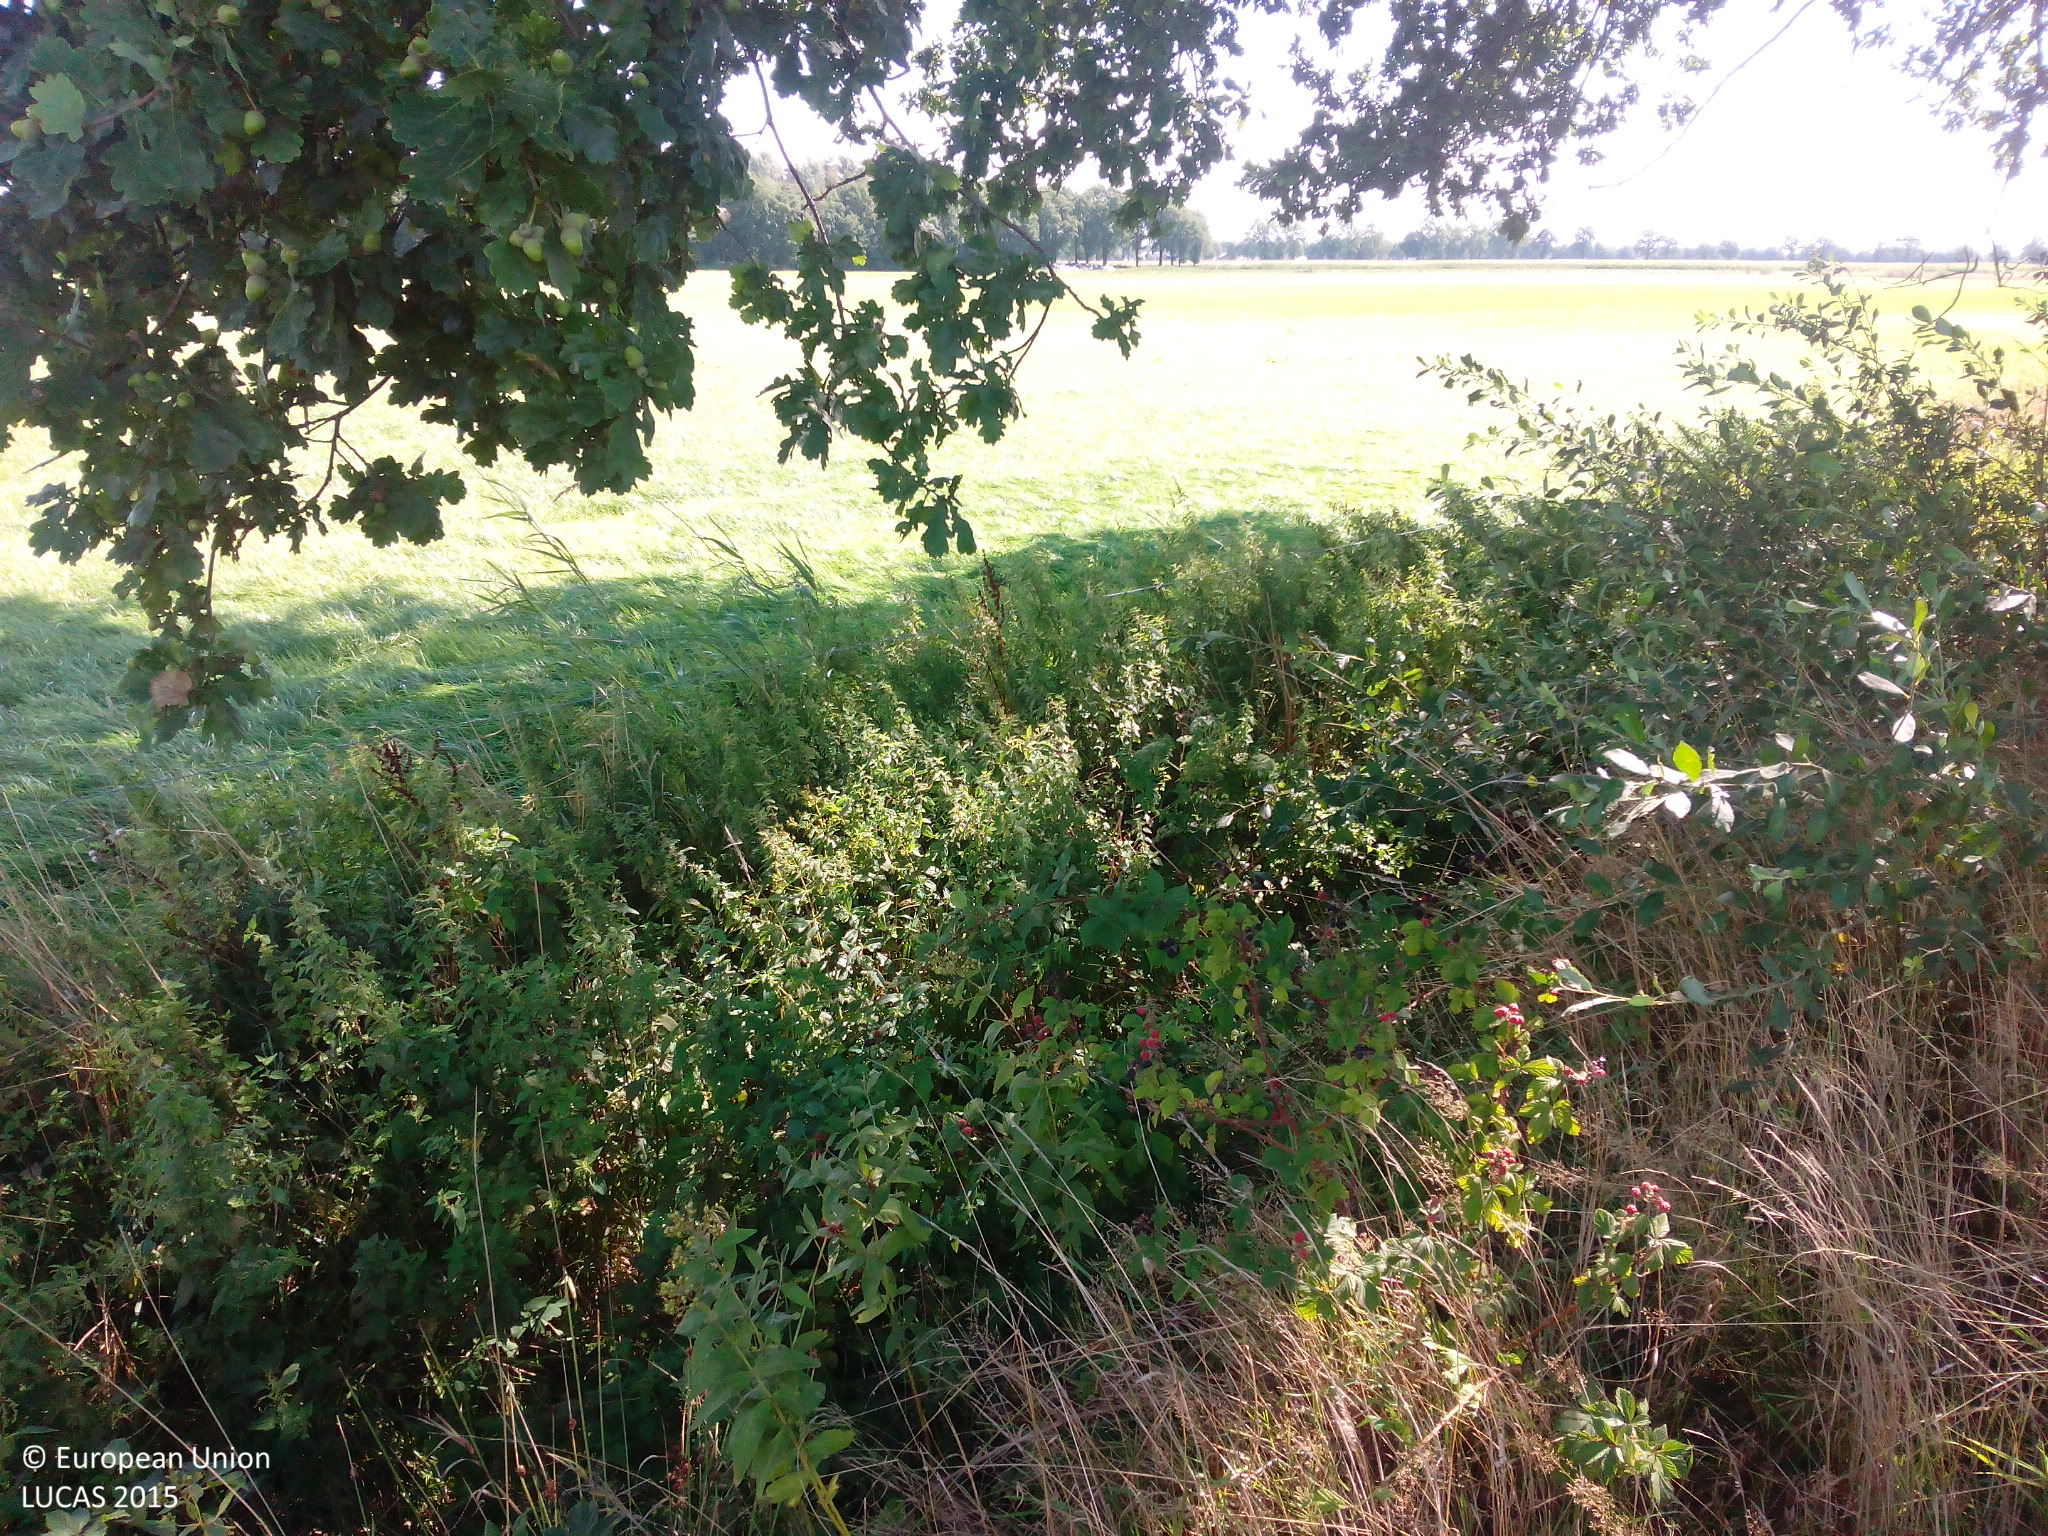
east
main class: Cropland
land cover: Maize
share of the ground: > 75 %
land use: Agriculture (excluding fallow land and kitchen gardens)
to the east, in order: Maize; Paved roads, cycling and walking lanes; Fences; Grassland without tree/shrub cover; Artificial constructions in urban areas; Grassland without tree/shrub cover
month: August
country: NL
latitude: 51.3099
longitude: 5.7091
